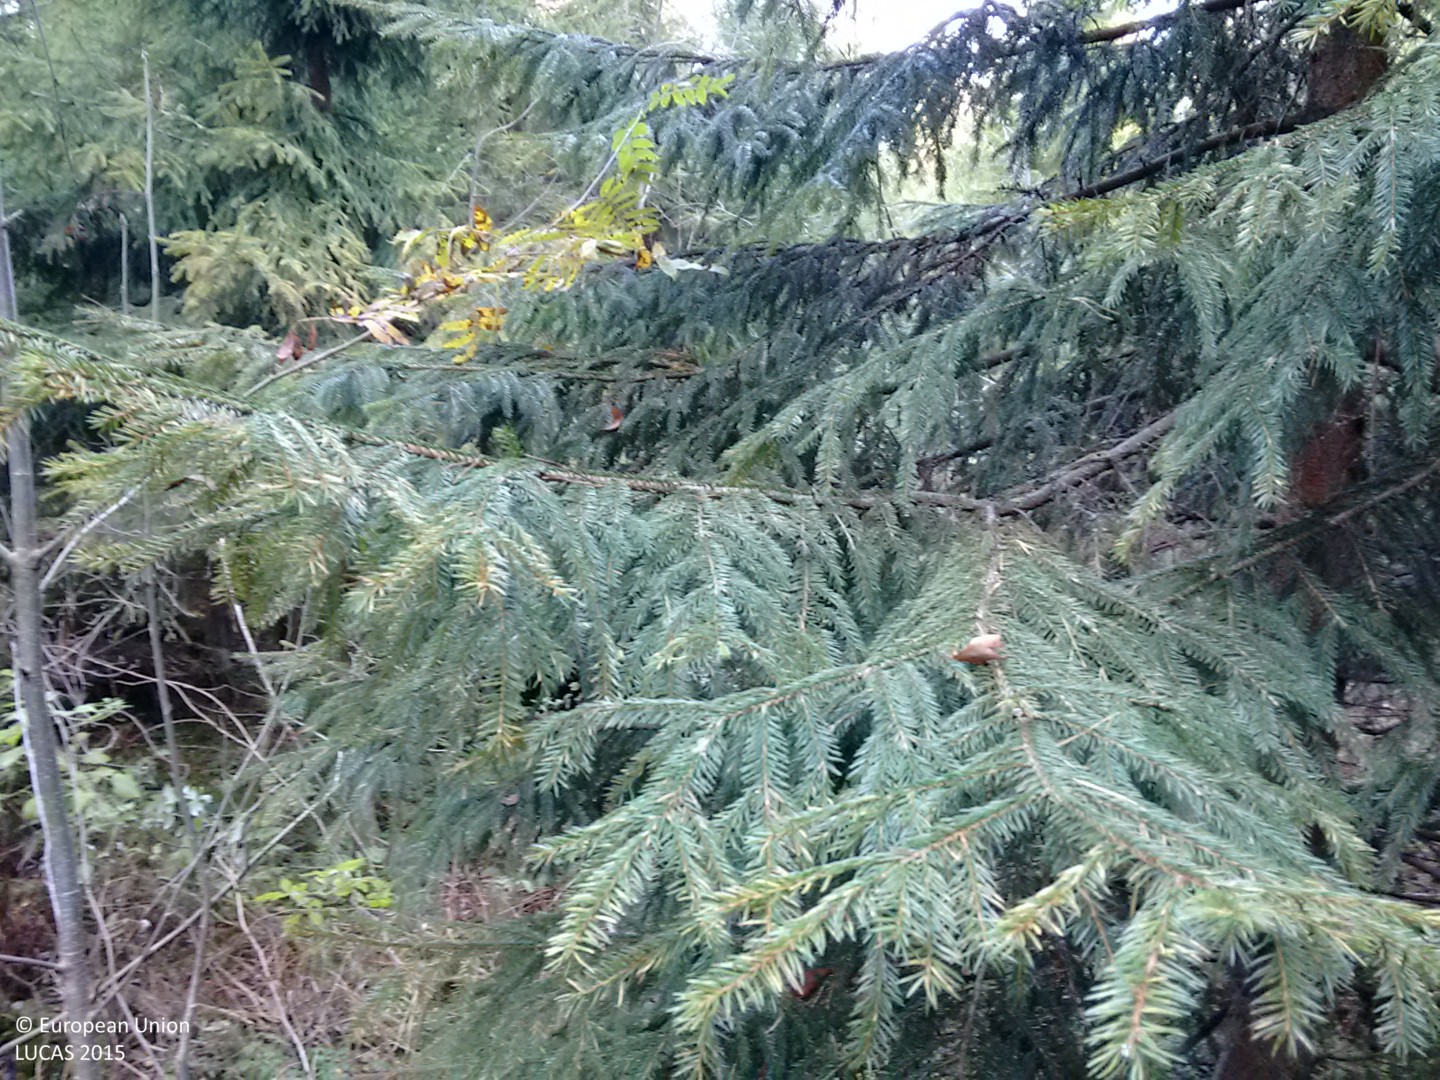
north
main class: Woodland
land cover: Spruce dominated coniferous woodland
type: hemiboreal forest and nemoral coniferous forest and mixed broadleaved-coniferous forest
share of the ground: > 75 %
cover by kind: coniferous forest trees 90 %, shrubs 10 %
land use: Forestry
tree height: > 5 m
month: October
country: FI
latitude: 62.6805
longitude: 25.9206
